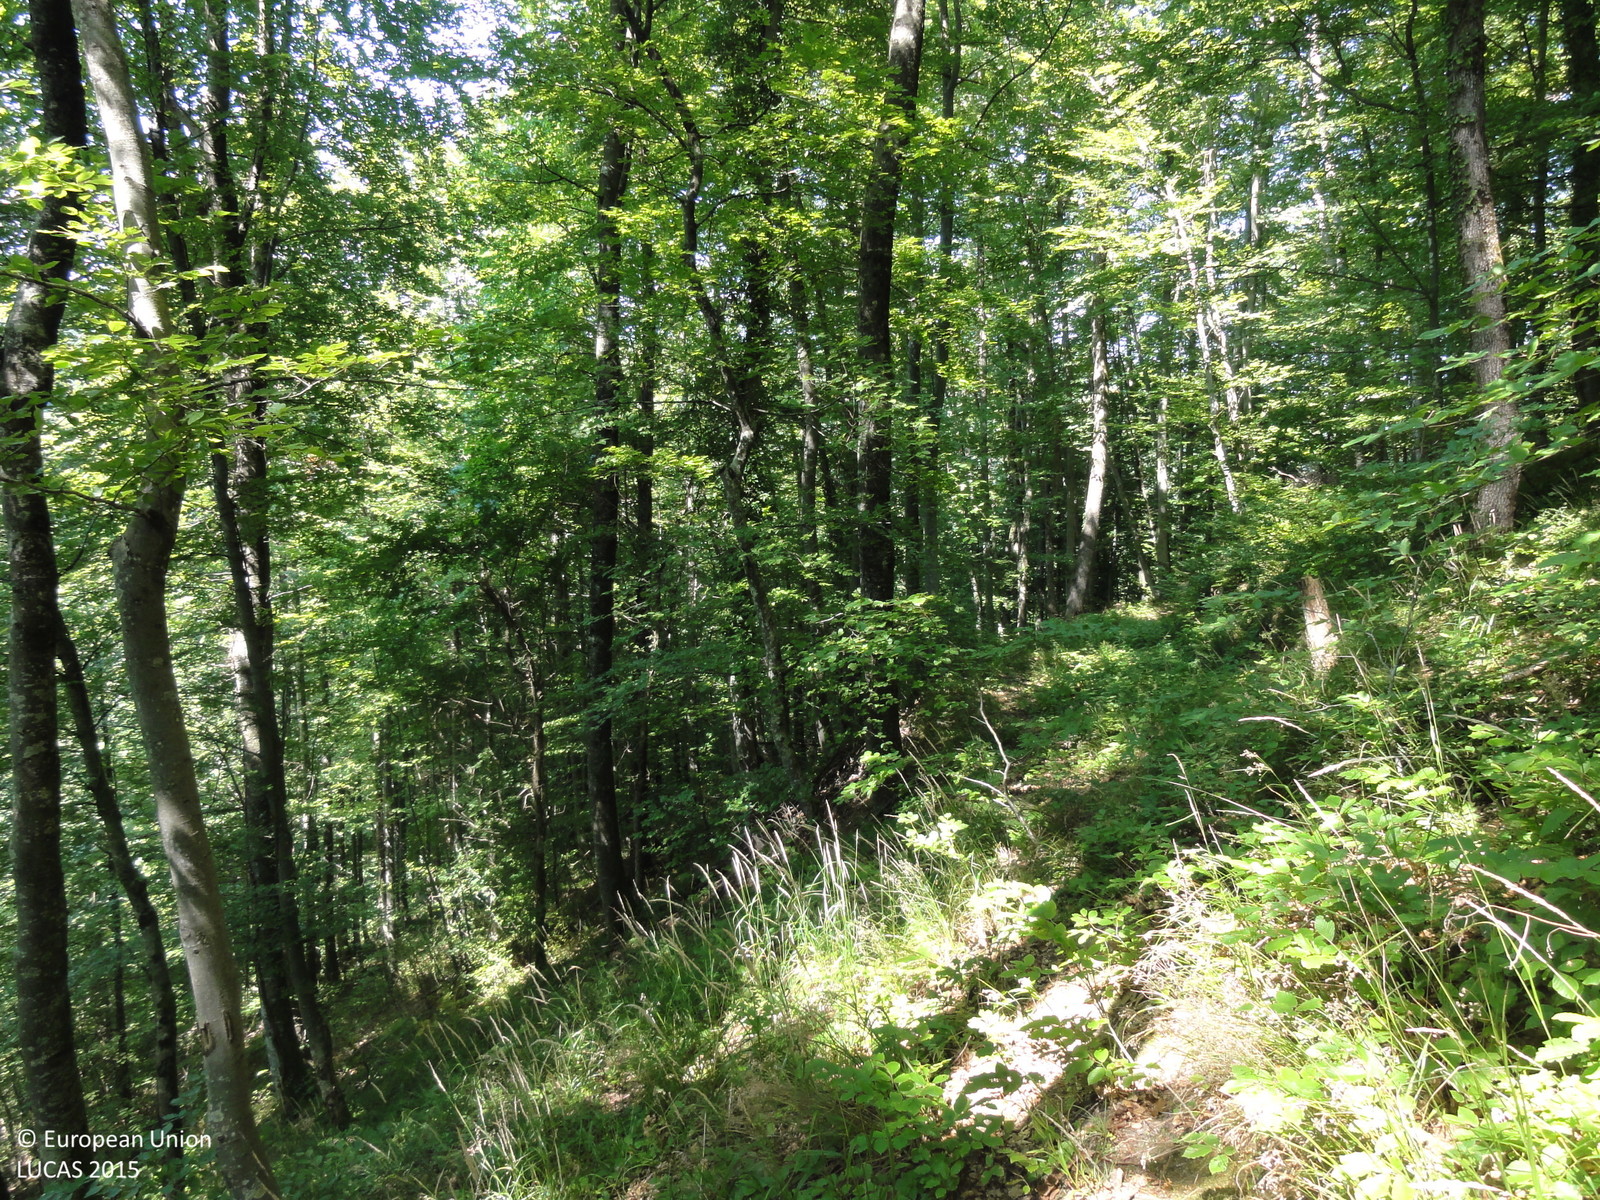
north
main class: Woodland
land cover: Broadleaved woodland
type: beech forest
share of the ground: > 75 %
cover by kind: broadleaved forest trees 100 %
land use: Forestry
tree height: > 5 m
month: August
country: SI
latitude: 45.9796
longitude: 15.0437
